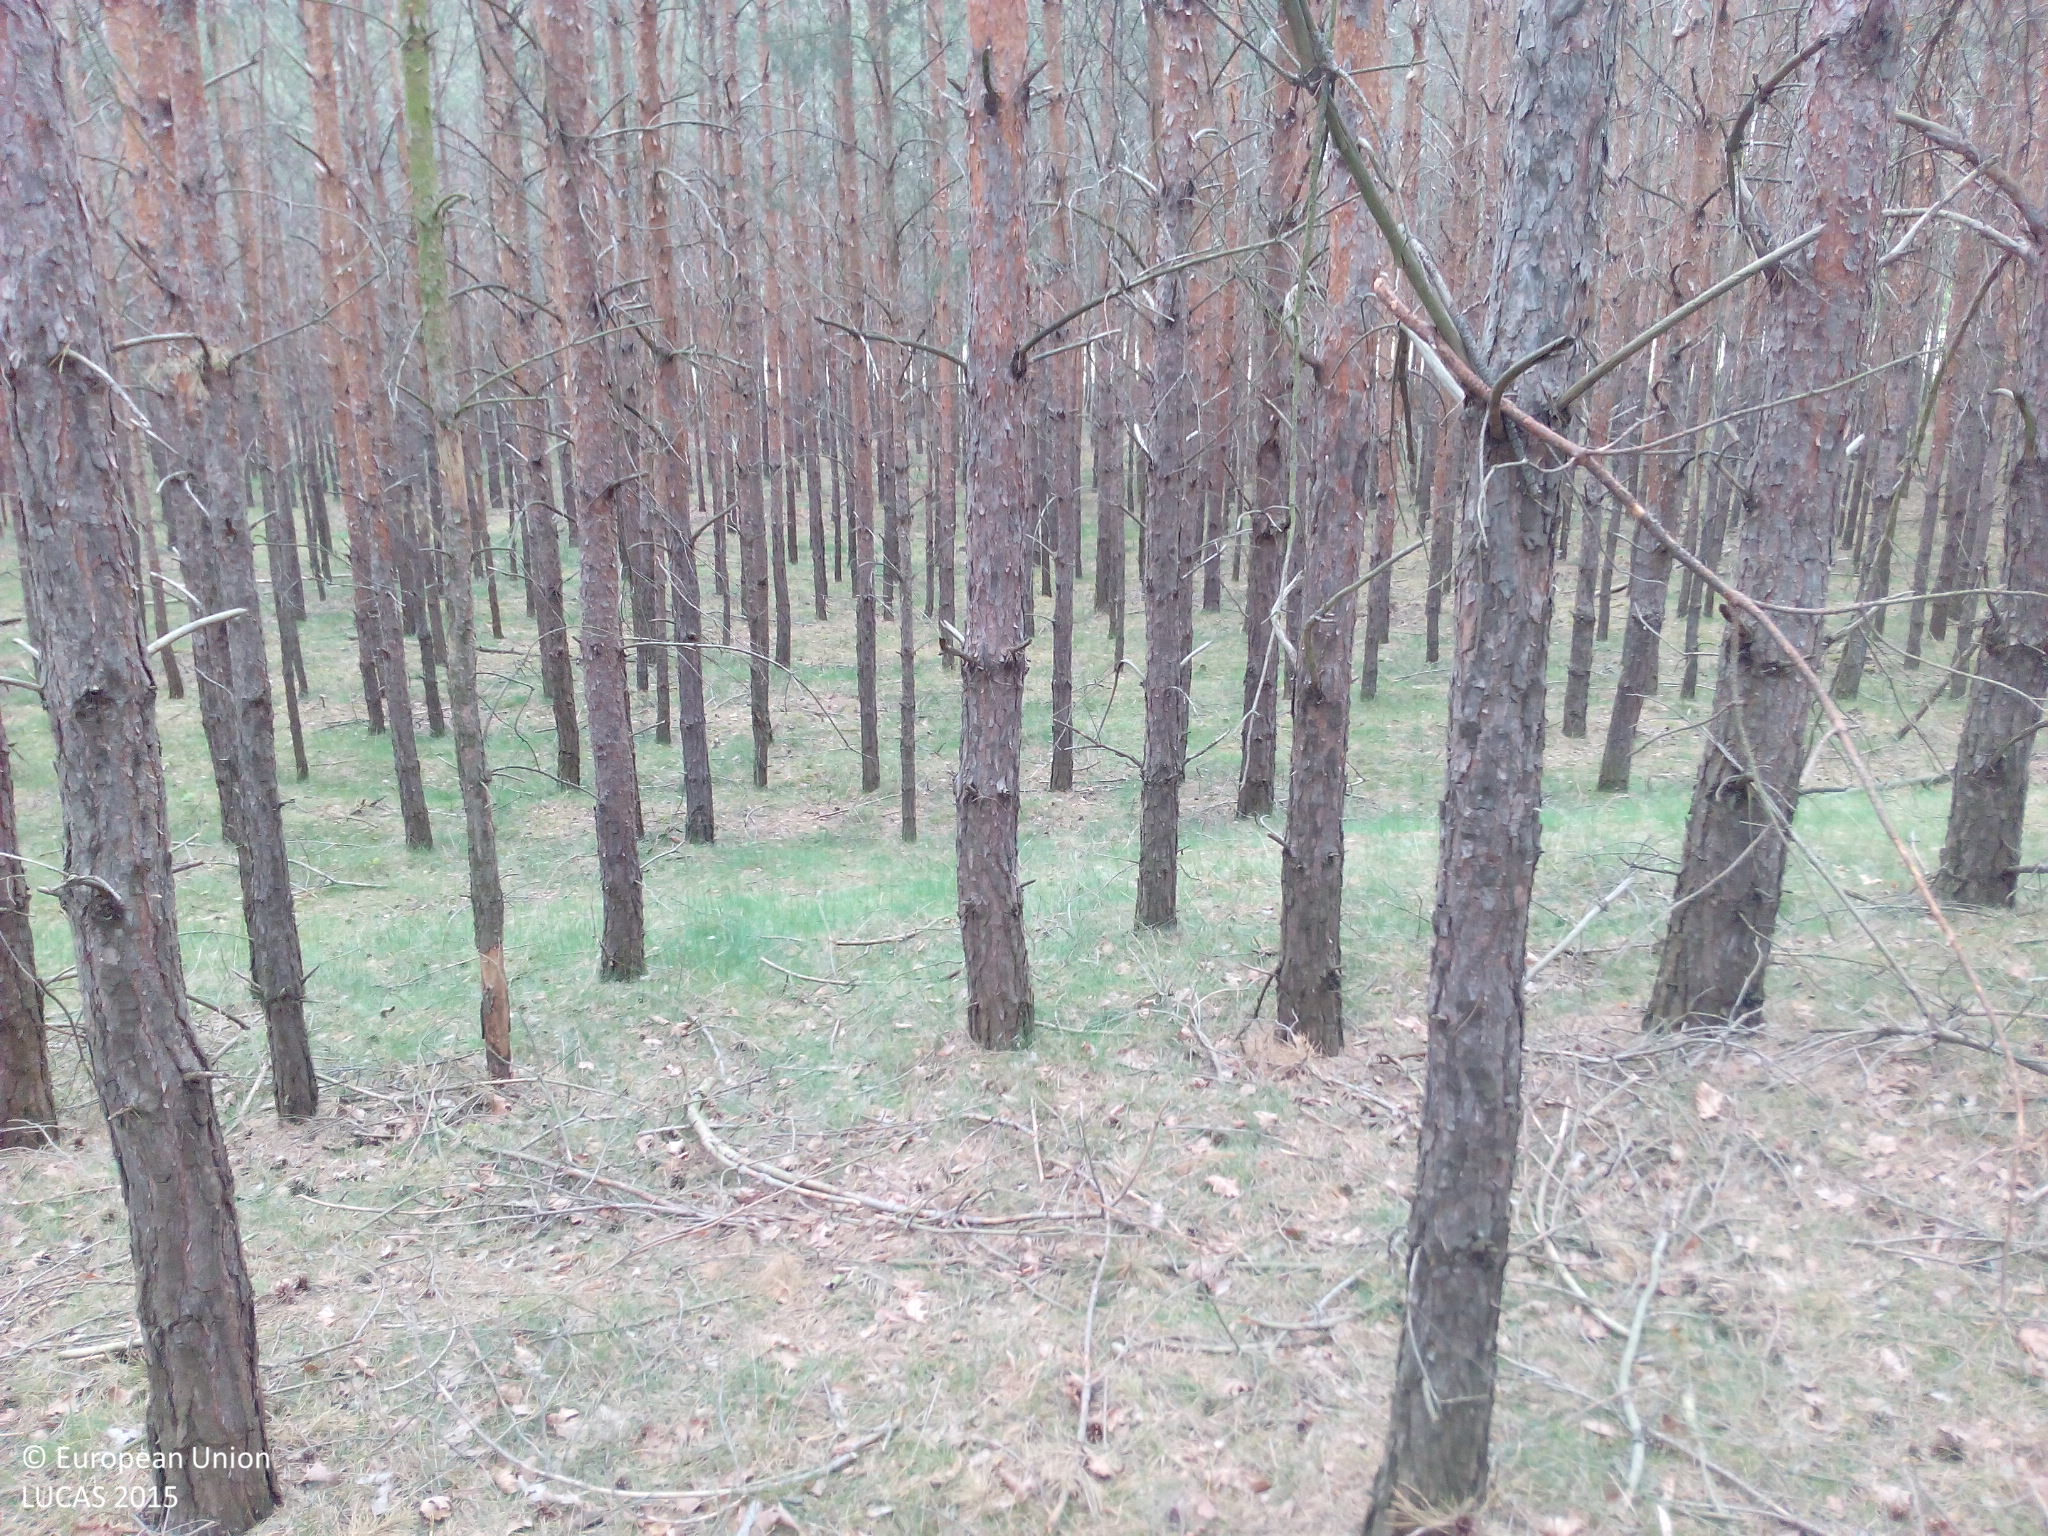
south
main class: Woodland
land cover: Pine dominated coniferous woodland
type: hemiboreal forest and nemoral coniferous forest and mixed broadleaved-coniferous forest
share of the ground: > 75 %
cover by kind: coniferous forest trees 80 %, herbaceous plants 10 %, unconsolidated bare surface 10 %
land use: Forestry
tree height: > 5 m
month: May
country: DE
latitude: 52.1919
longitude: 13.1451
